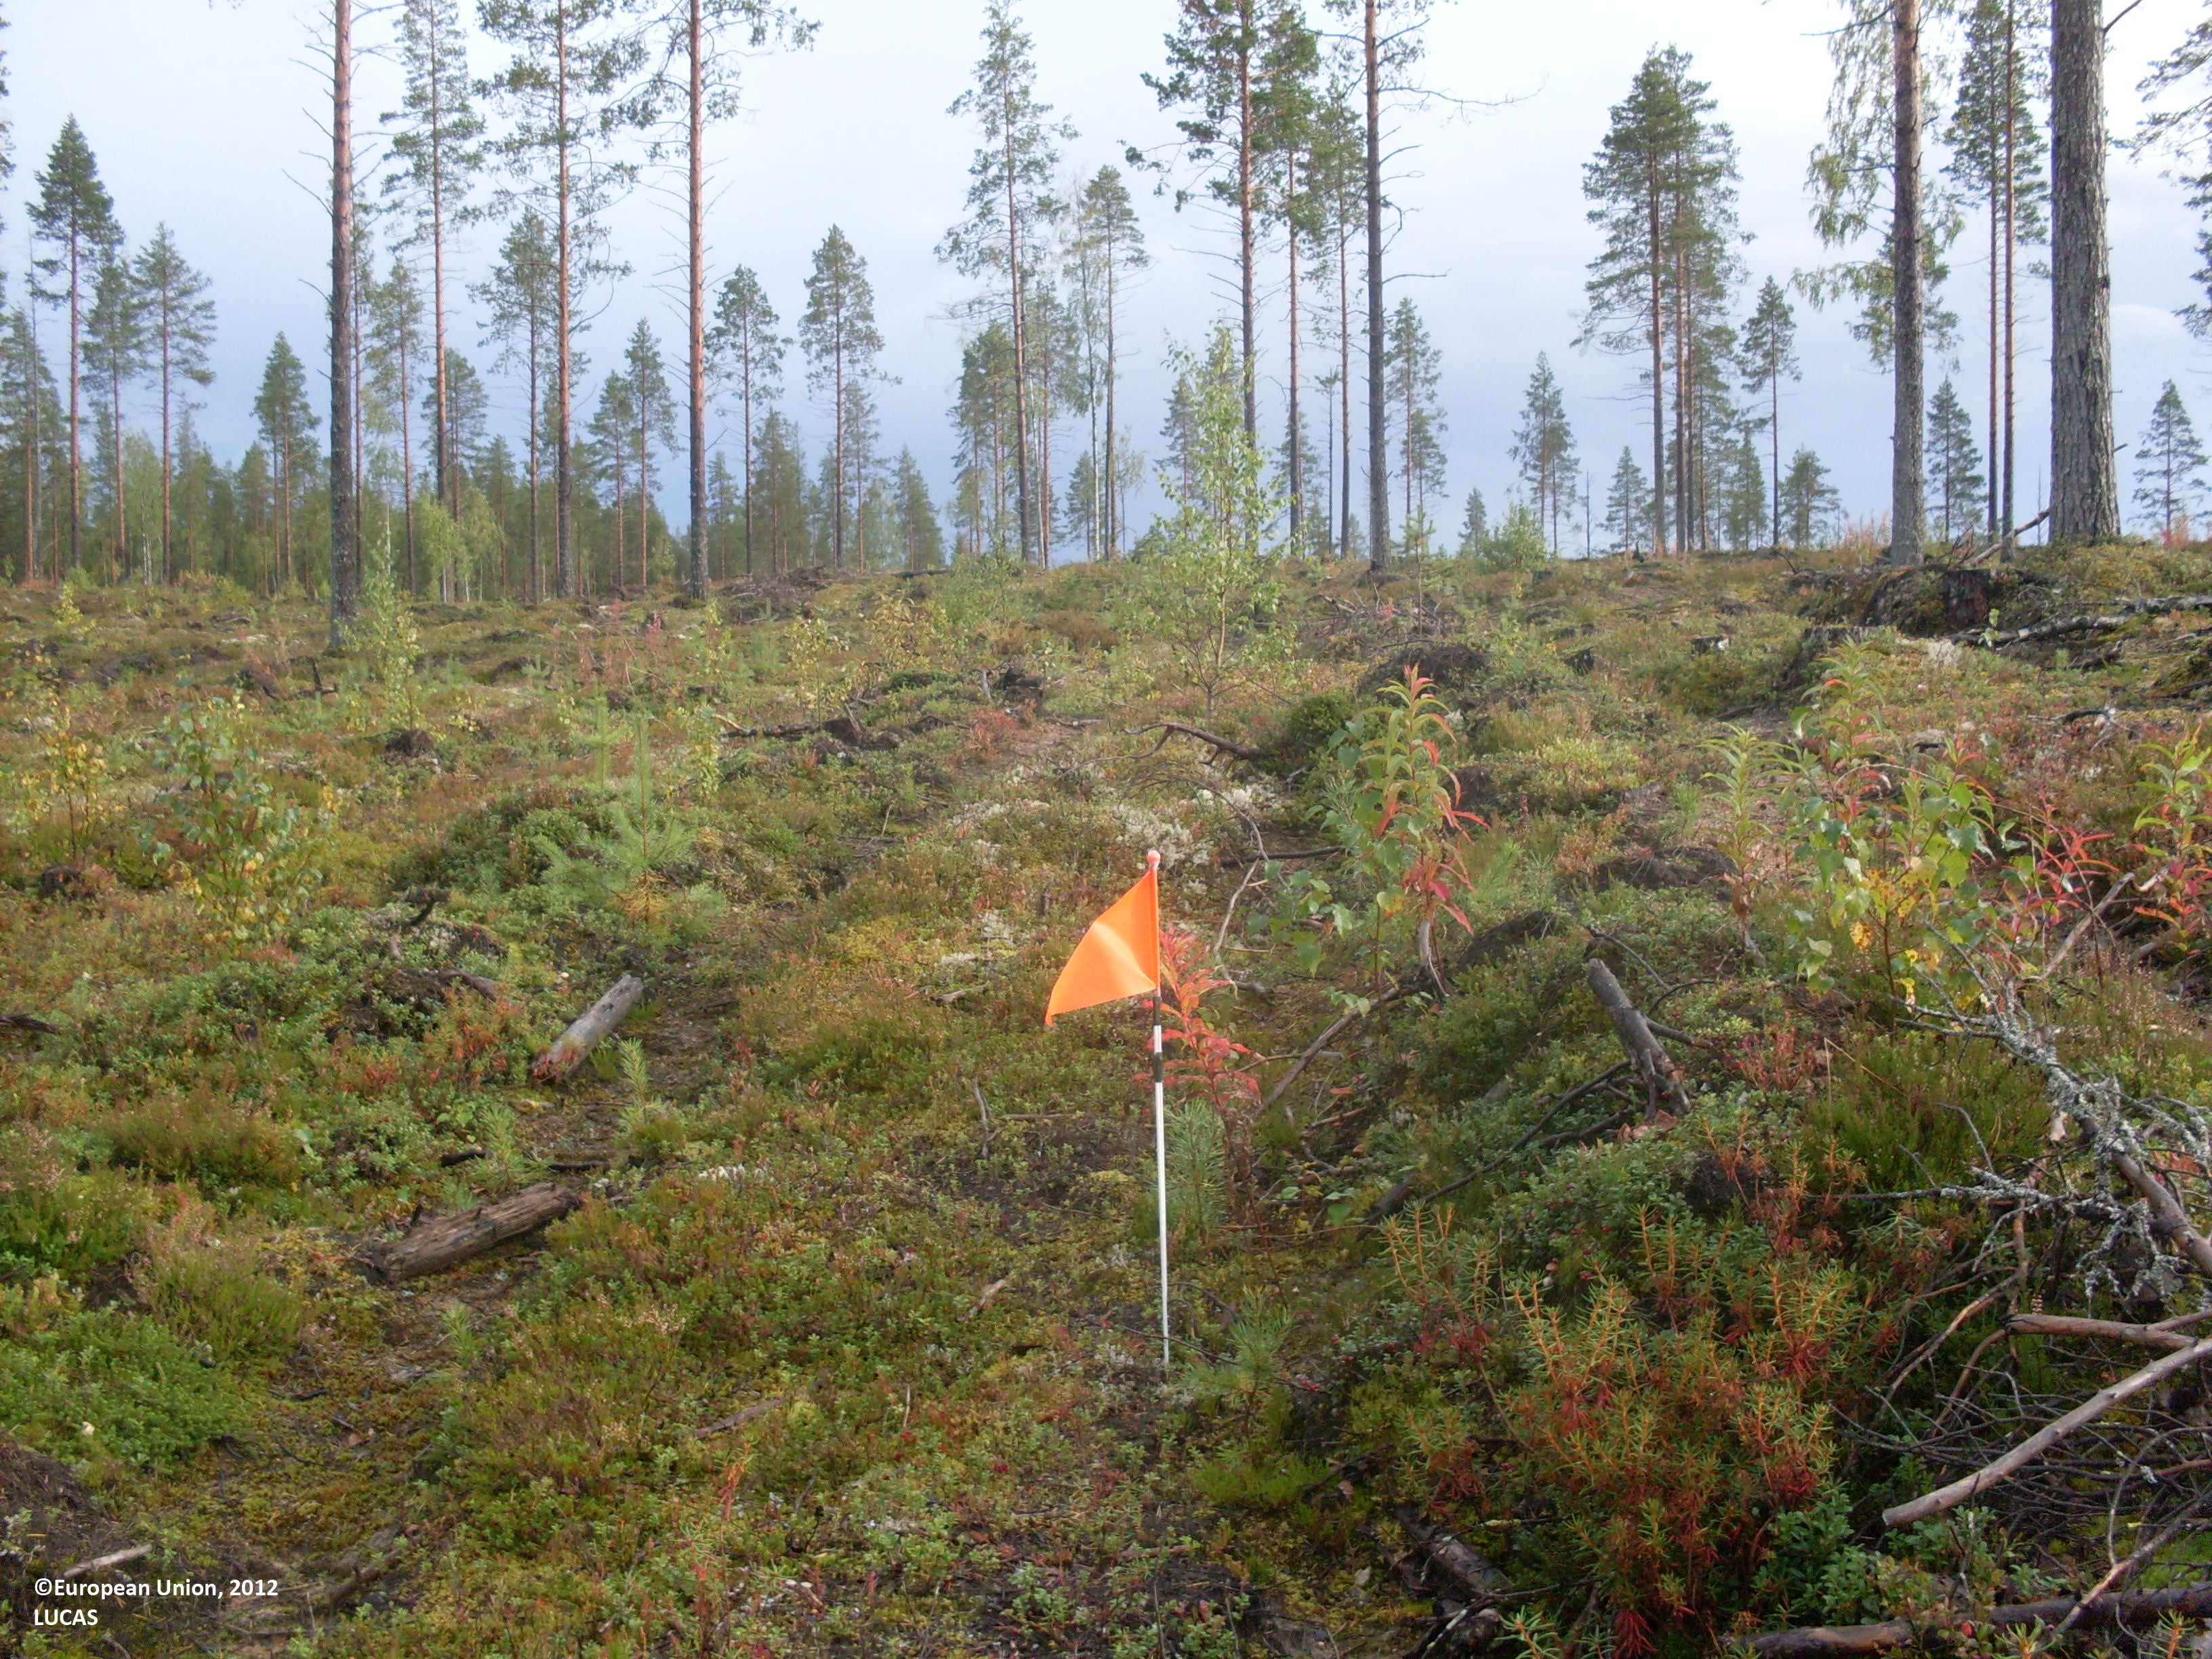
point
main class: Woodland
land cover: Pine dominated coniferous woodland
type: boreal forest
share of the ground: 10 - 25 %
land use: Forestry
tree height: < 5 m
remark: Nursery
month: September
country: FI
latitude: 64.1570
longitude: 29.8264
